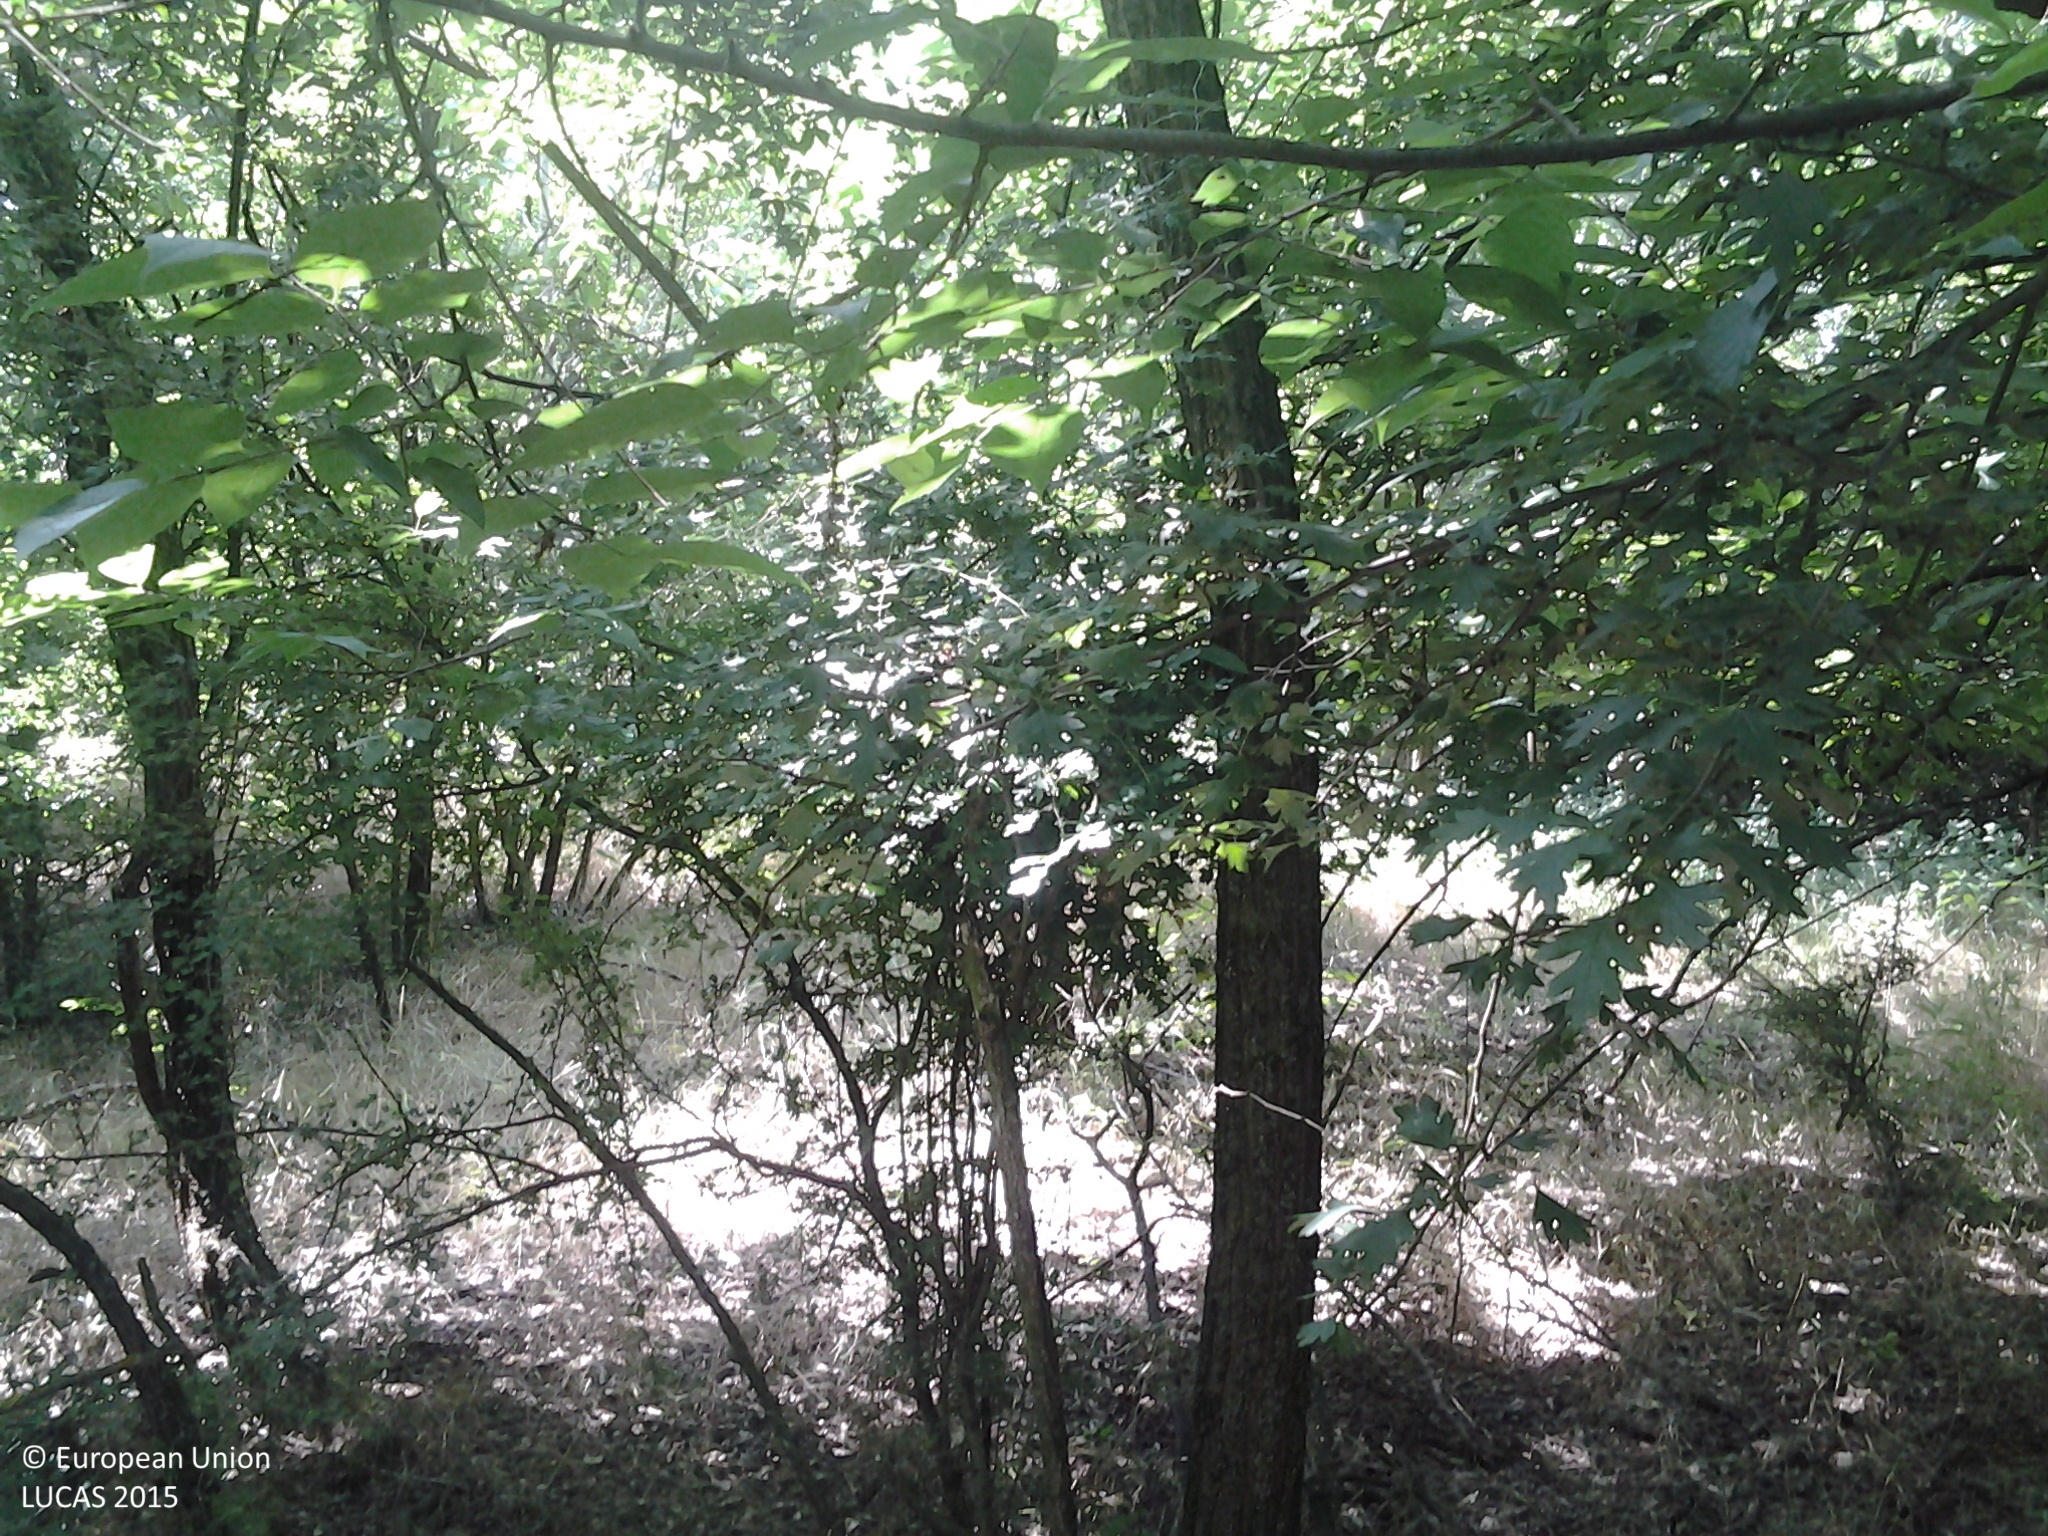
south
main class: Woodland
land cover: Broadleaved woodland
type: mesophytic deciduous forest
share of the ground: > 75 %
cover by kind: broadleaved forest trees 95 %, shrubs 5 %
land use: Forestry
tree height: > 5 m
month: June
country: HU
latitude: 46.8047
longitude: 19.6246
